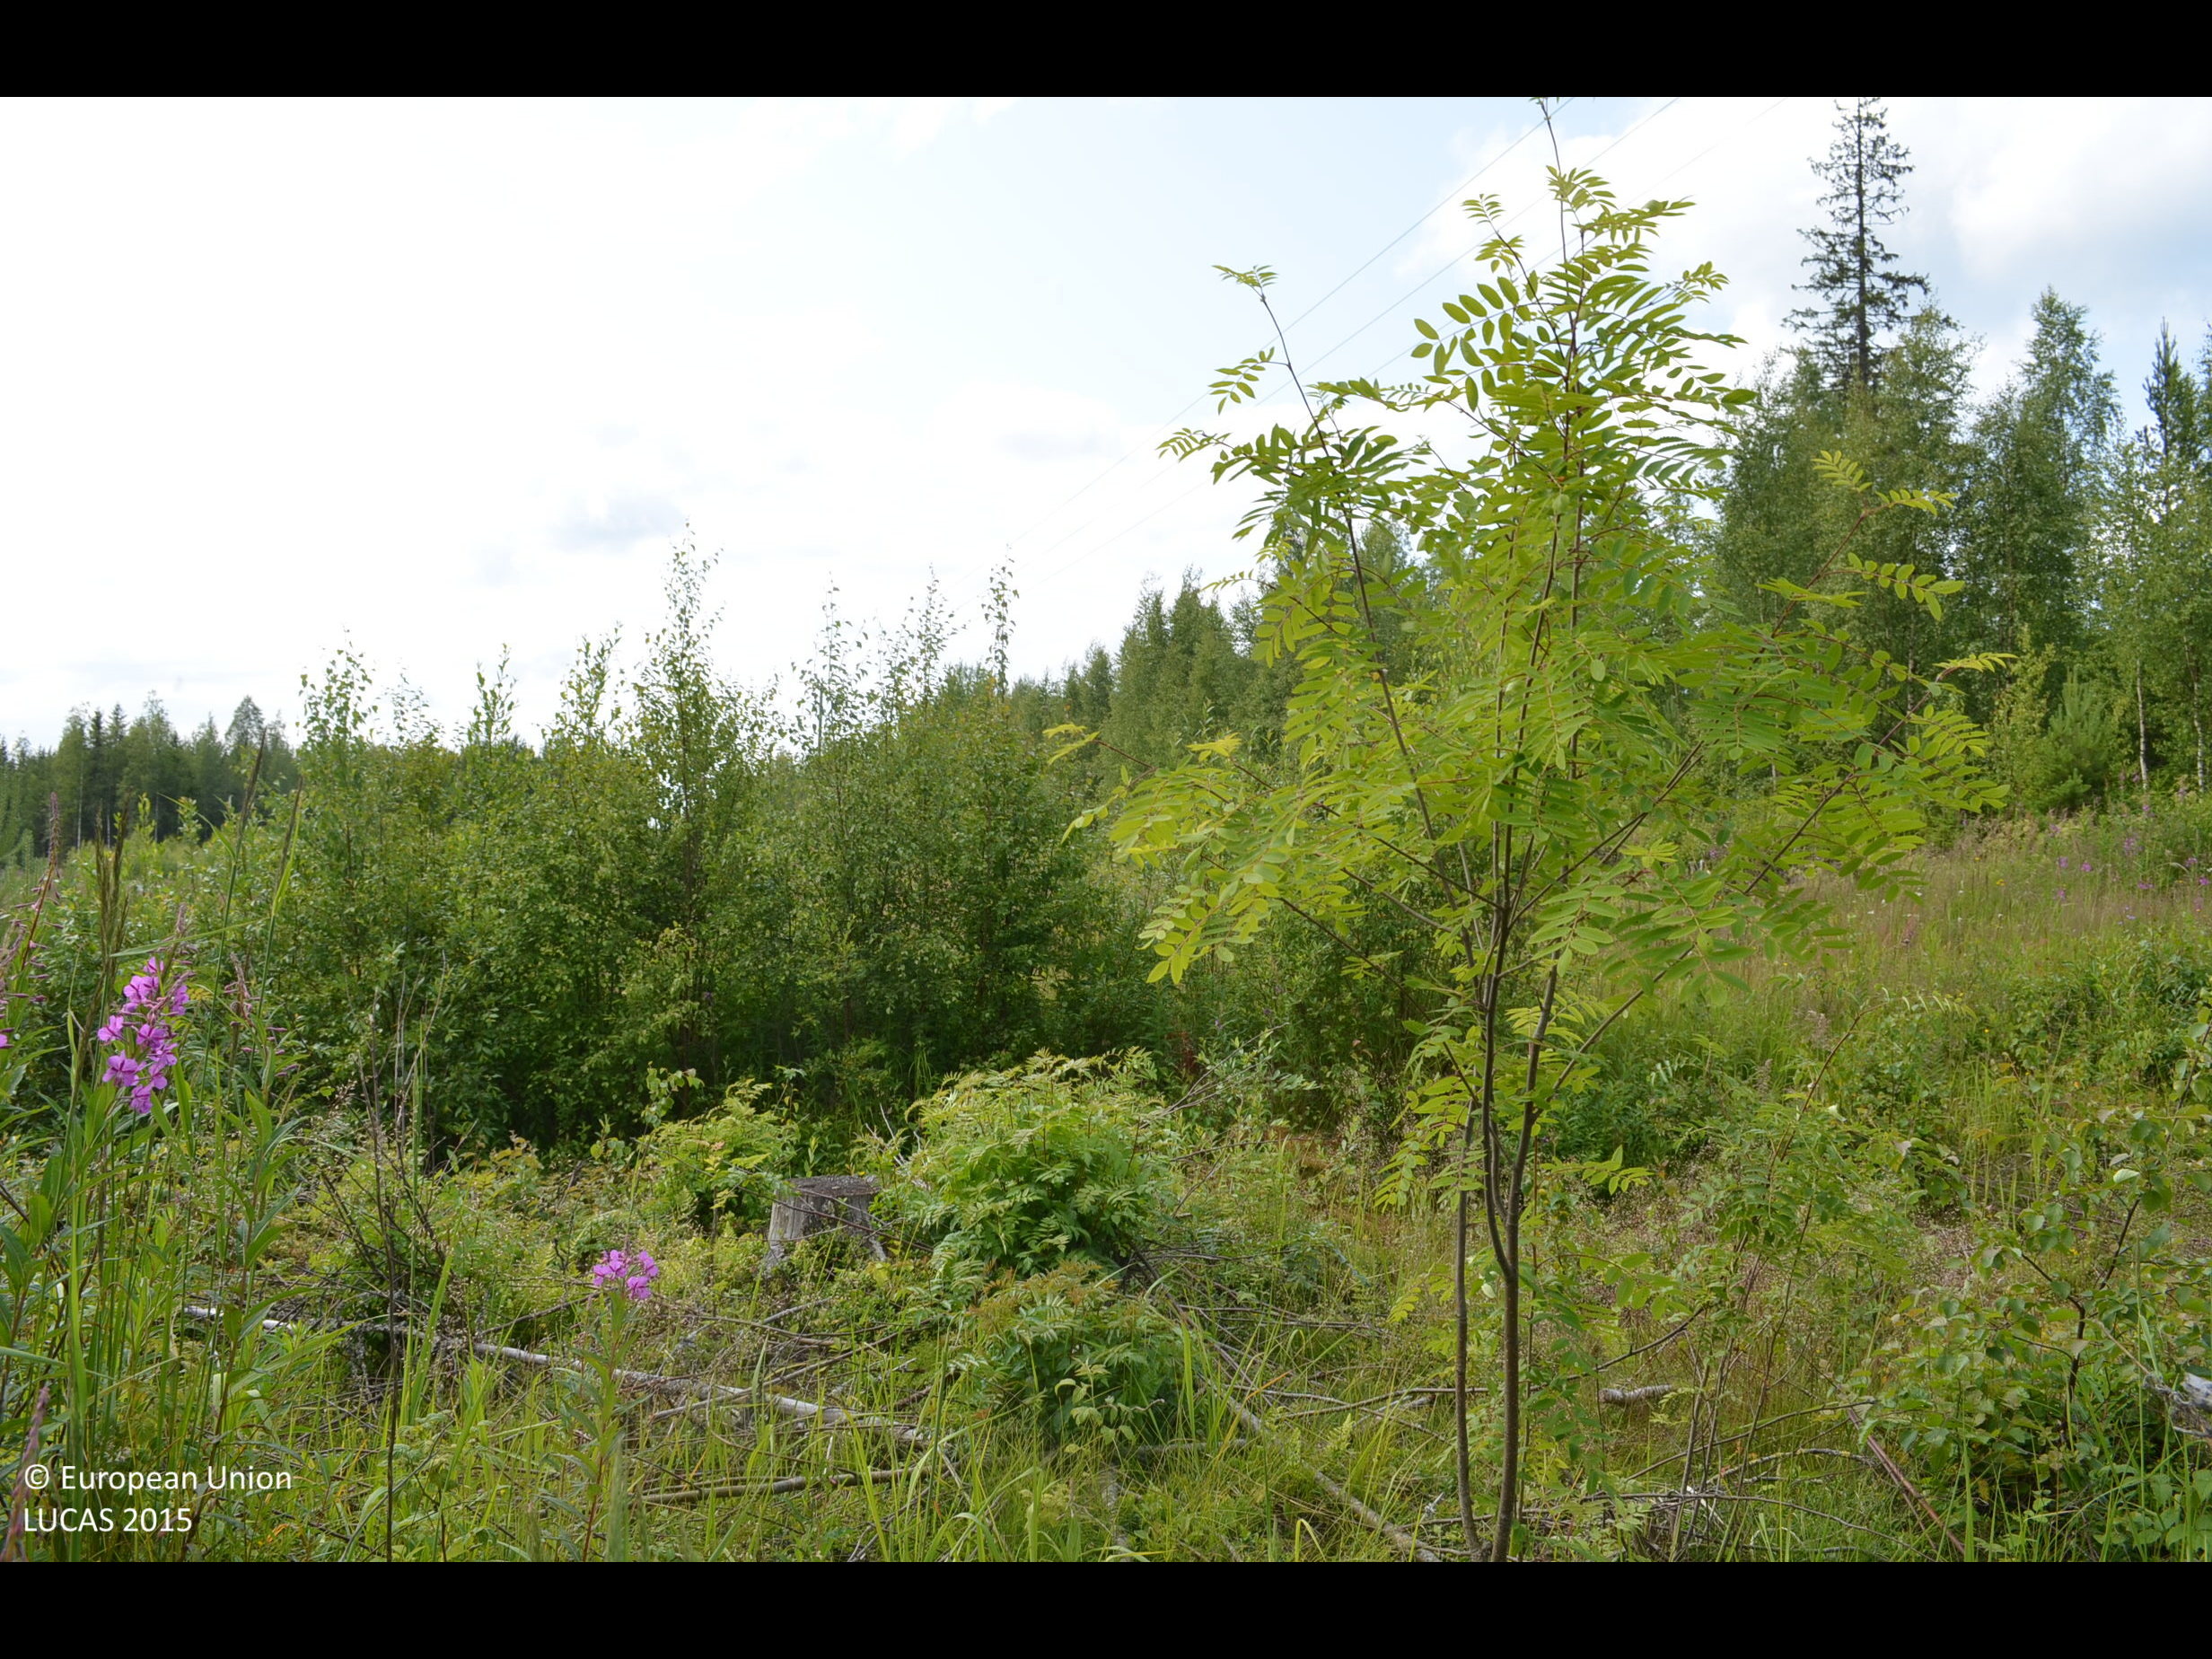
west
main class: Woodland
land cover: Broadleaved woodland
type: boreal forest
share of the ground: > 75 %
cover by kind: broadleaved forest trees 70 %, coniferous forest trees 15 %, herbaceous plants 10 %, shrubs 5 %
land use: Forestry
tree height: > 5 m
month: July
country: FI
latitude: 62.2124
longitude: 23.5922
